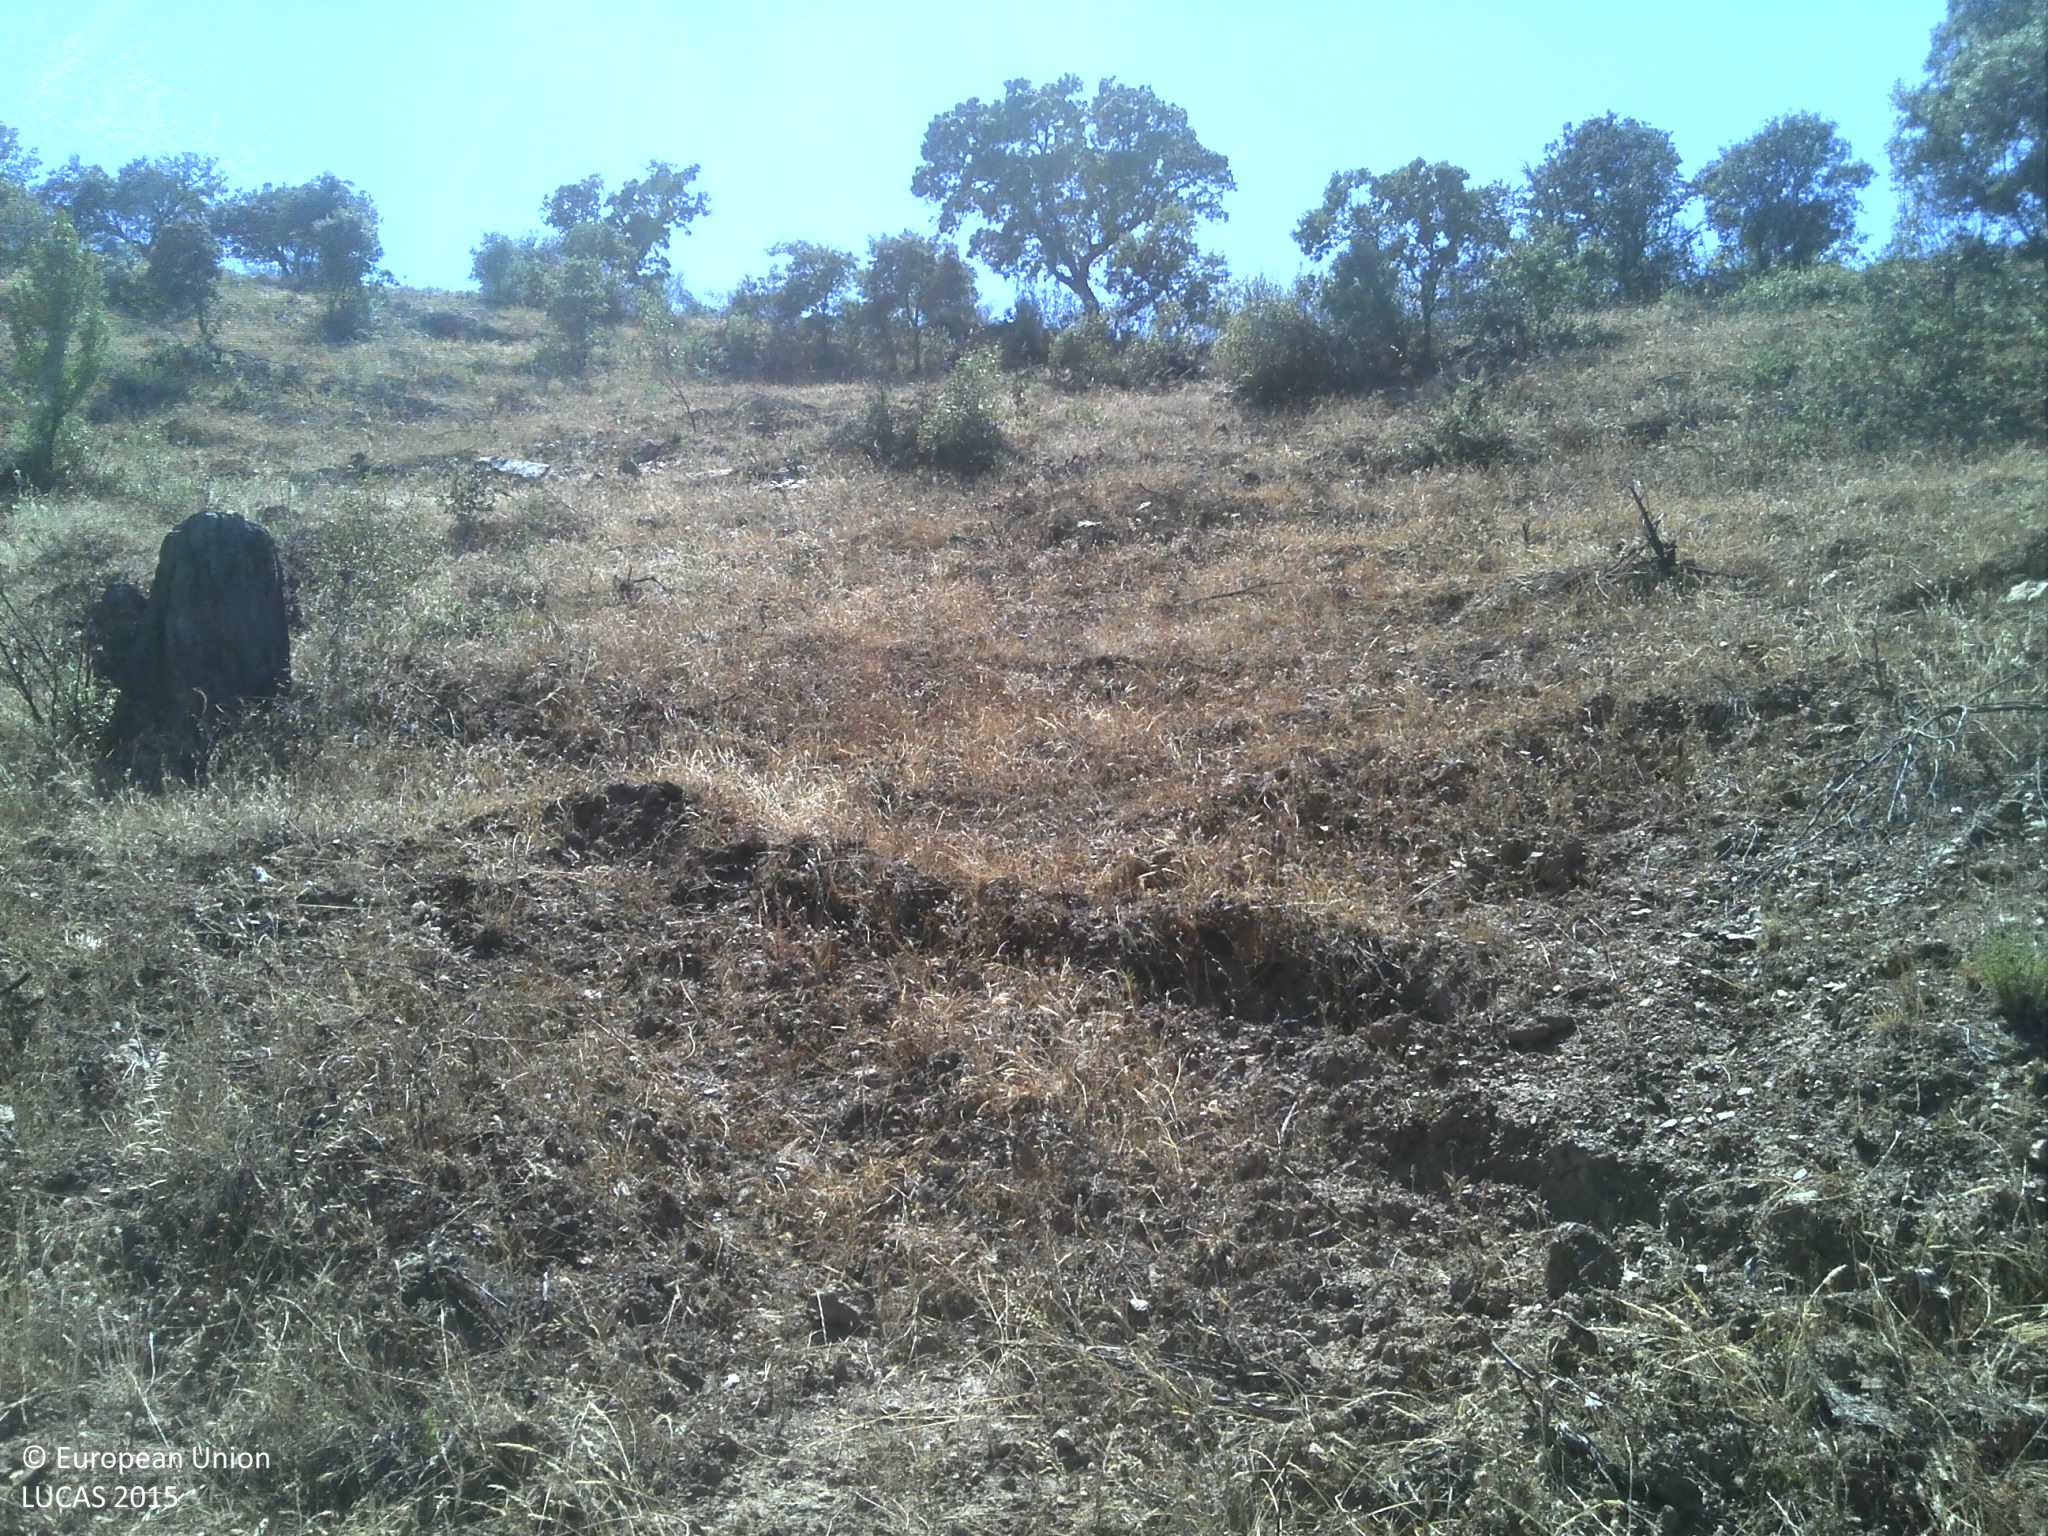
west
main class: Grassland
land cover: Grassland with sparse tree/shrub cover
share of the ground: 25 - 50 %
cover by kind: herbaceous plants 40 %, unconsolidated bare surface 40 %, broadleaved forest trees 5 %, shrubs 5 %
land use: Agriculture (excluding fallow land and kitchen gardens)
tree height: < 5 m
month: June
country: PT
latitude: 39.9889
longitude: -7.2054
